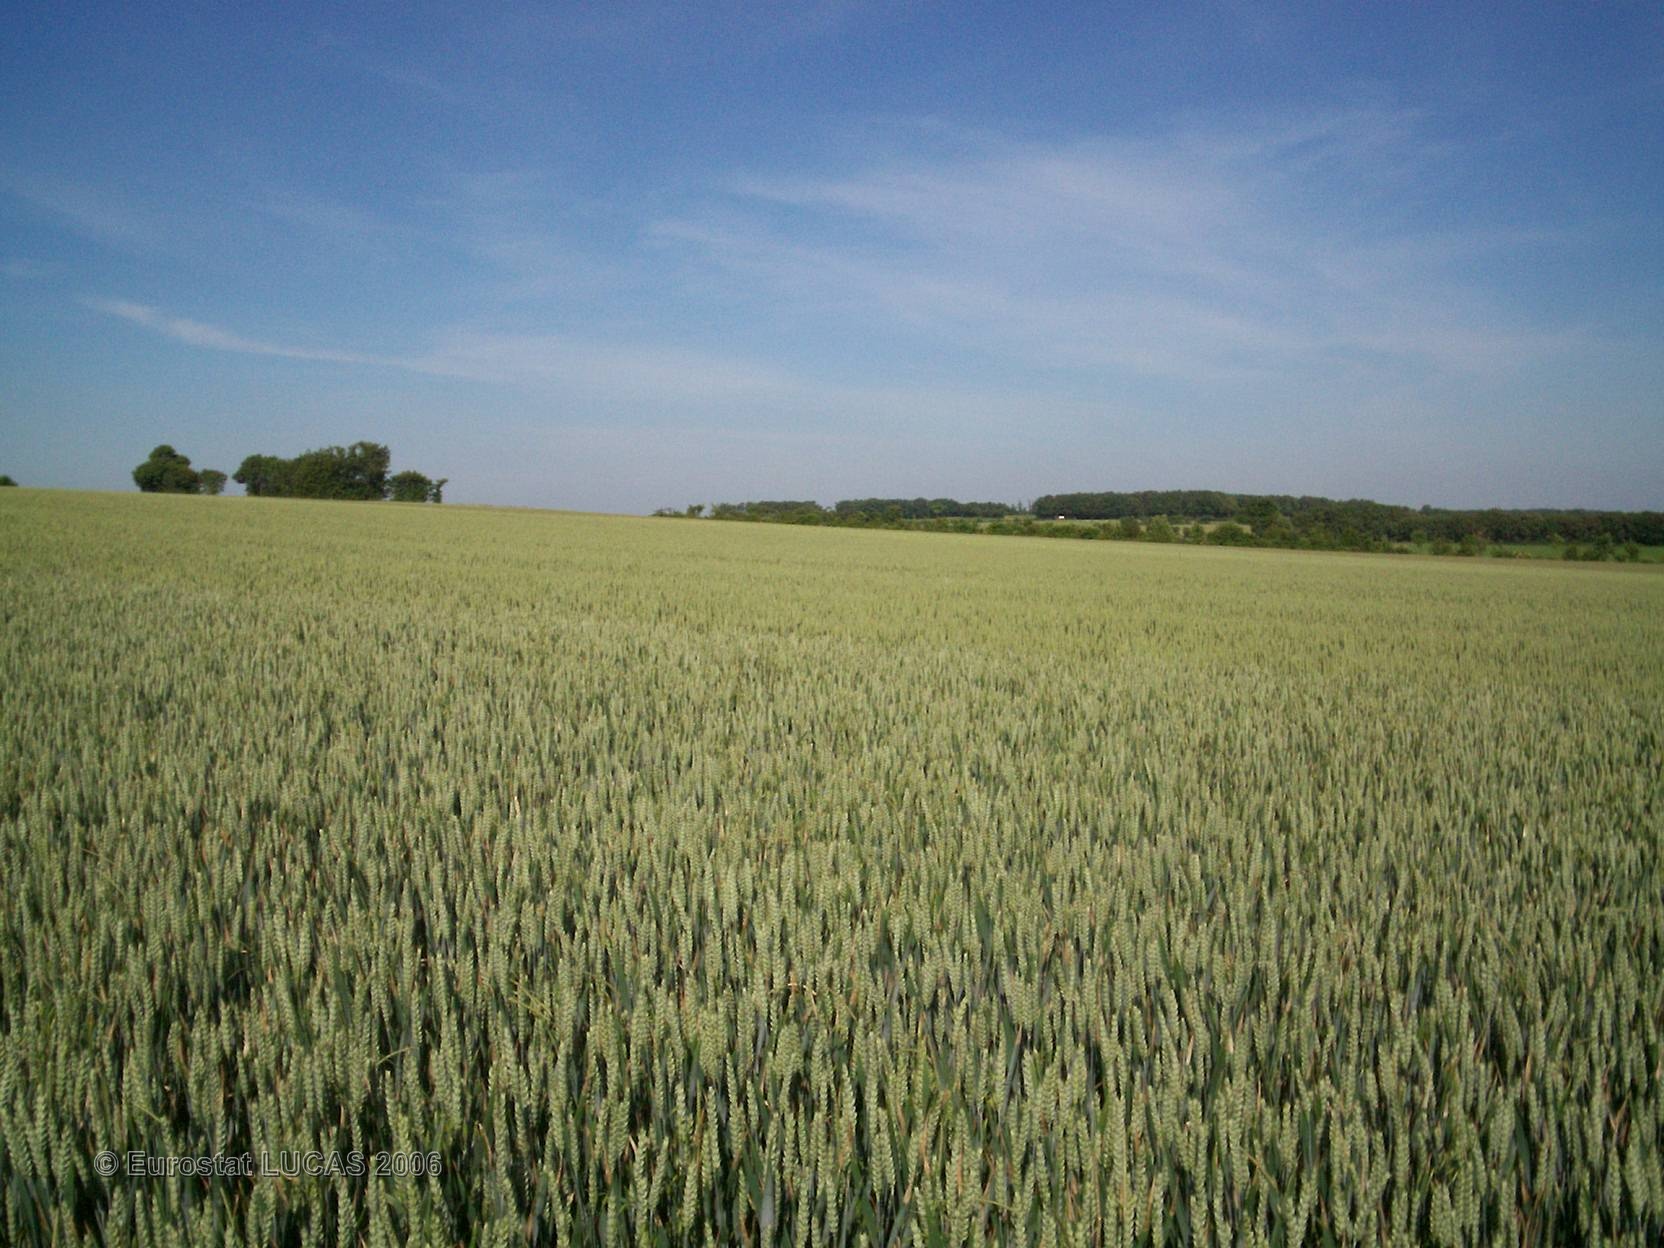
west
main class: Cropland
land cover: Common wheat
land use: Agriculture (excluding fallow land and kitchen gardens)
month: June
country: FR
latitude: 46.0680
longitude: -0.6922
